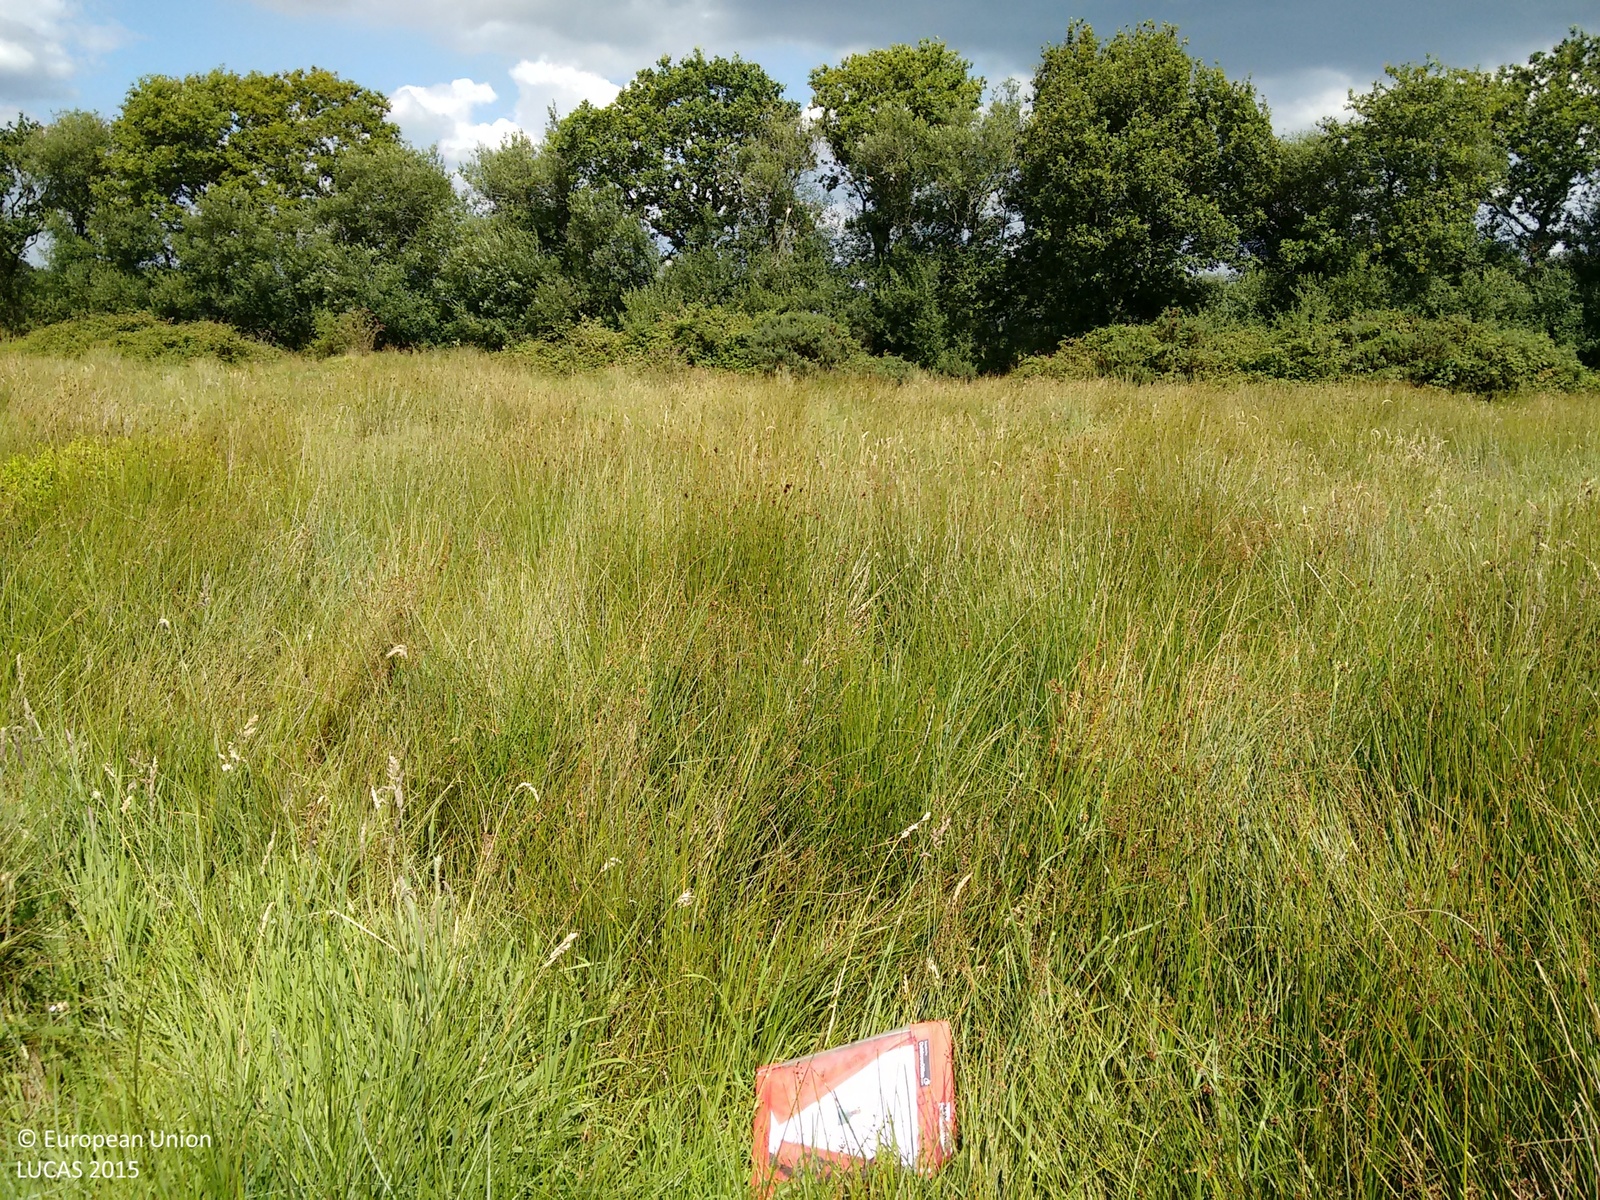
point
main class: Grassland
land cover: Grassland without tree/shrub cover
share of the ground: > 75 %
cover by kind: herbaceous plants 100 %
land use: Agriculture (excluding fallow land and kitchen gardens)
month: August
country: GB
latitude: 51.8158
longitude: -4.4510
